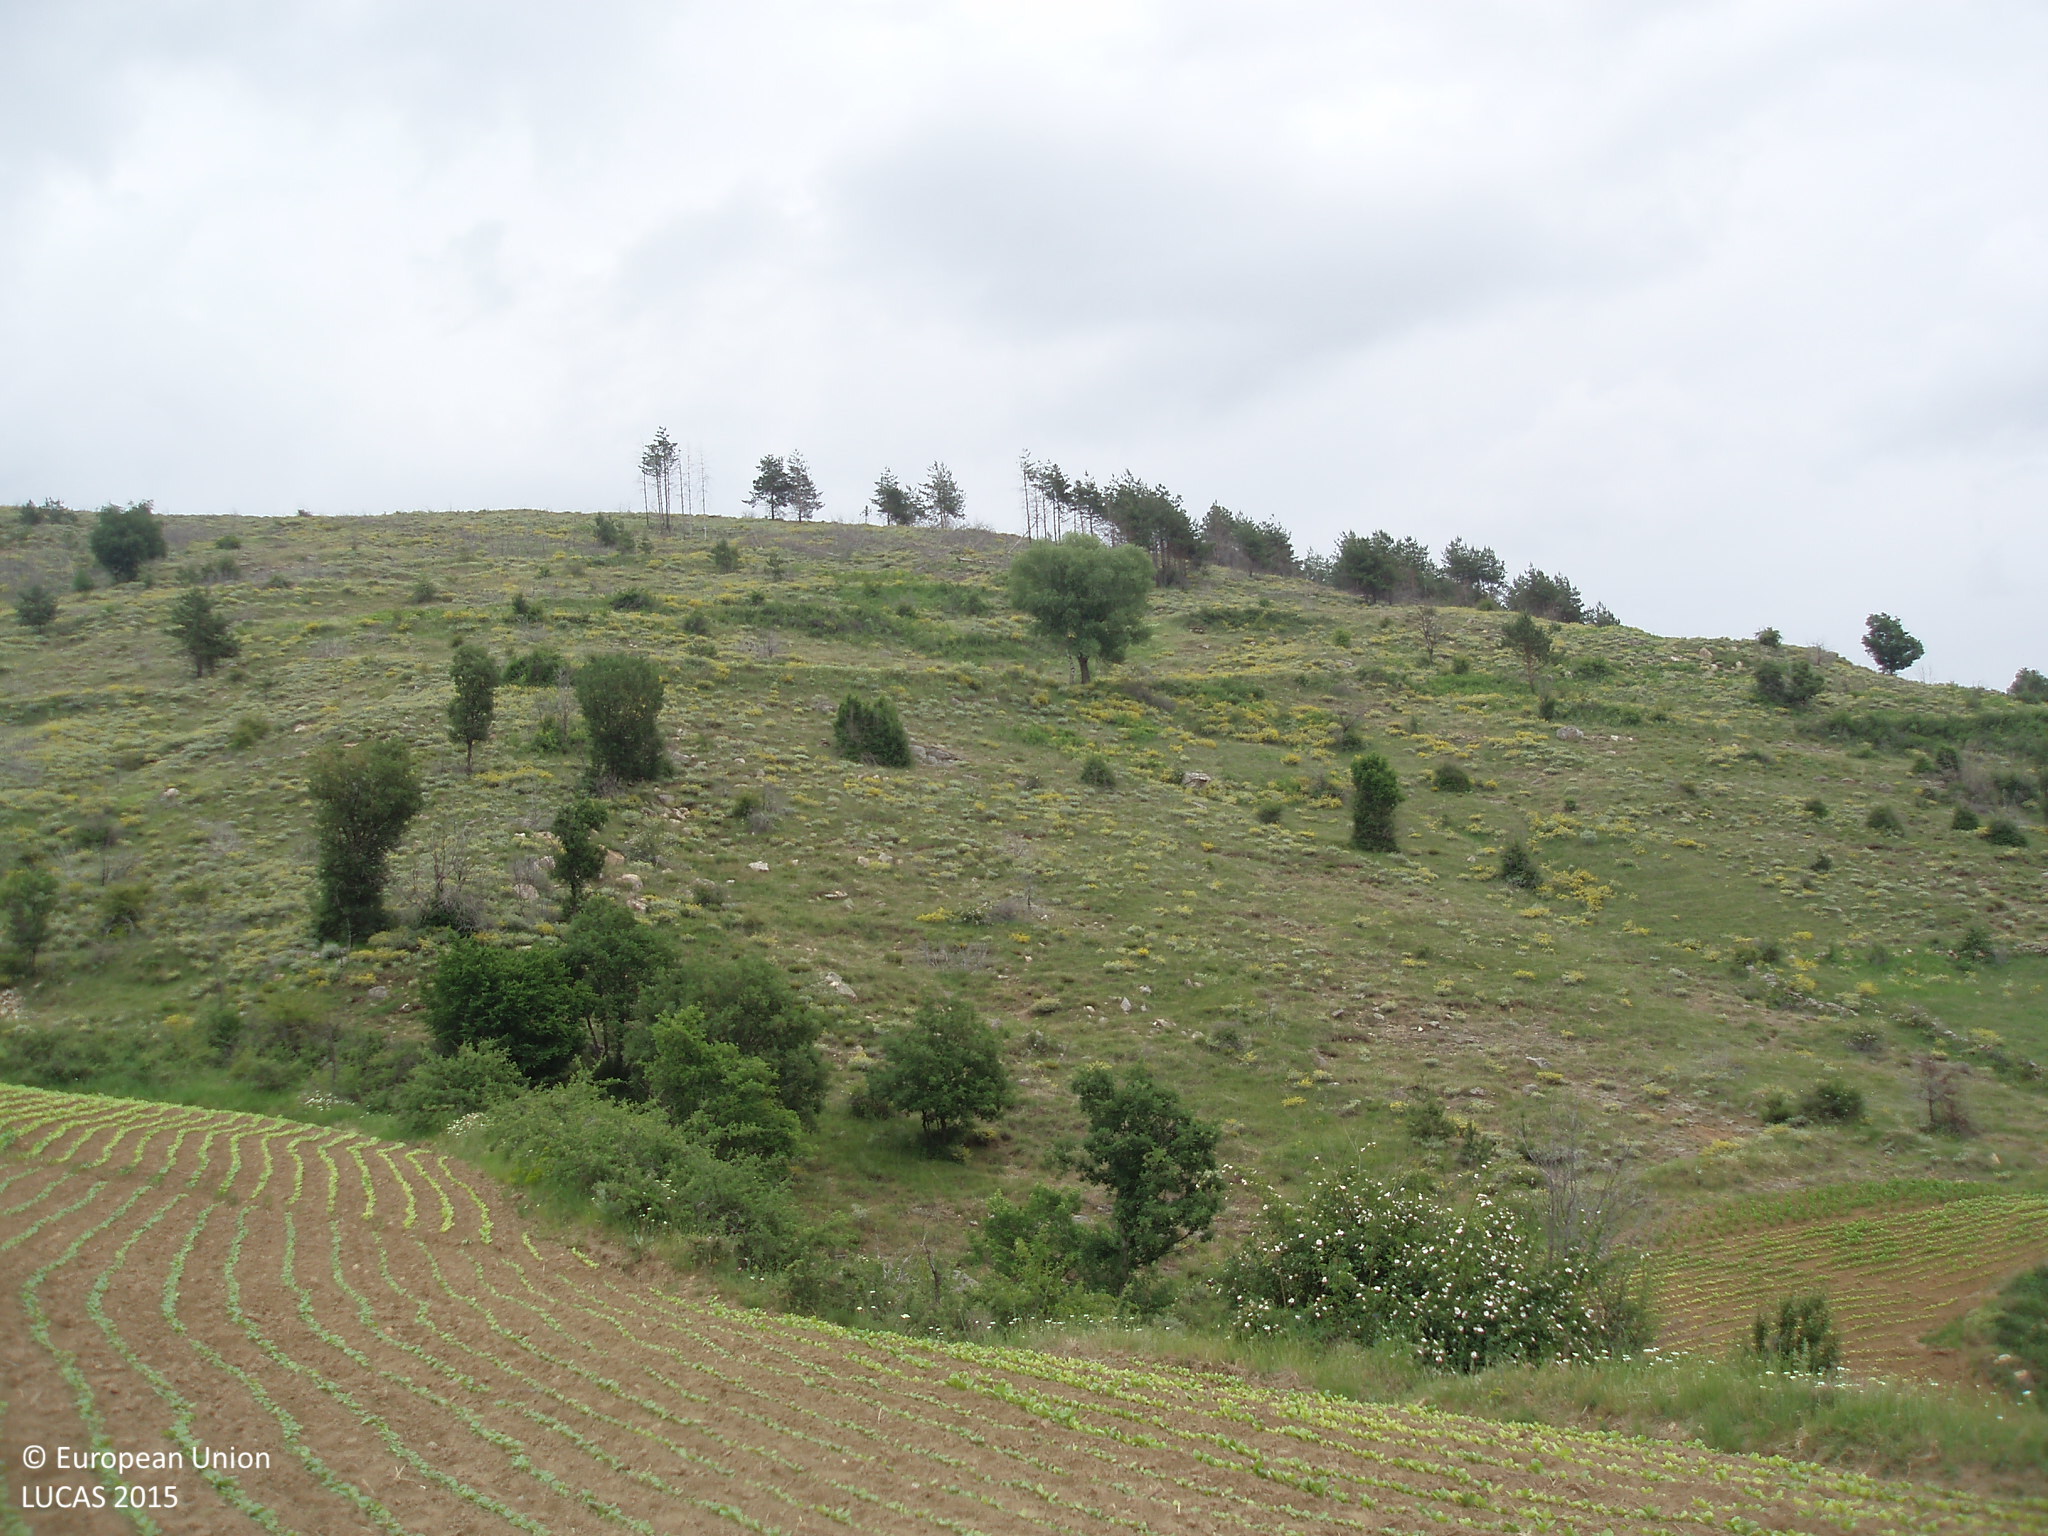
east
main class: Cropland
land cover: Tobacco
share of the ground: 25 - 50 %
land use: Agriculture (excluding fallow land and kitchen gardens)
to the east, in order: Tobacco; Shrubland without tree cover; Grassland with sparse tree/shrub cover
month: June
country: BG
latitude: 41.5627
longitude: 24.0261
